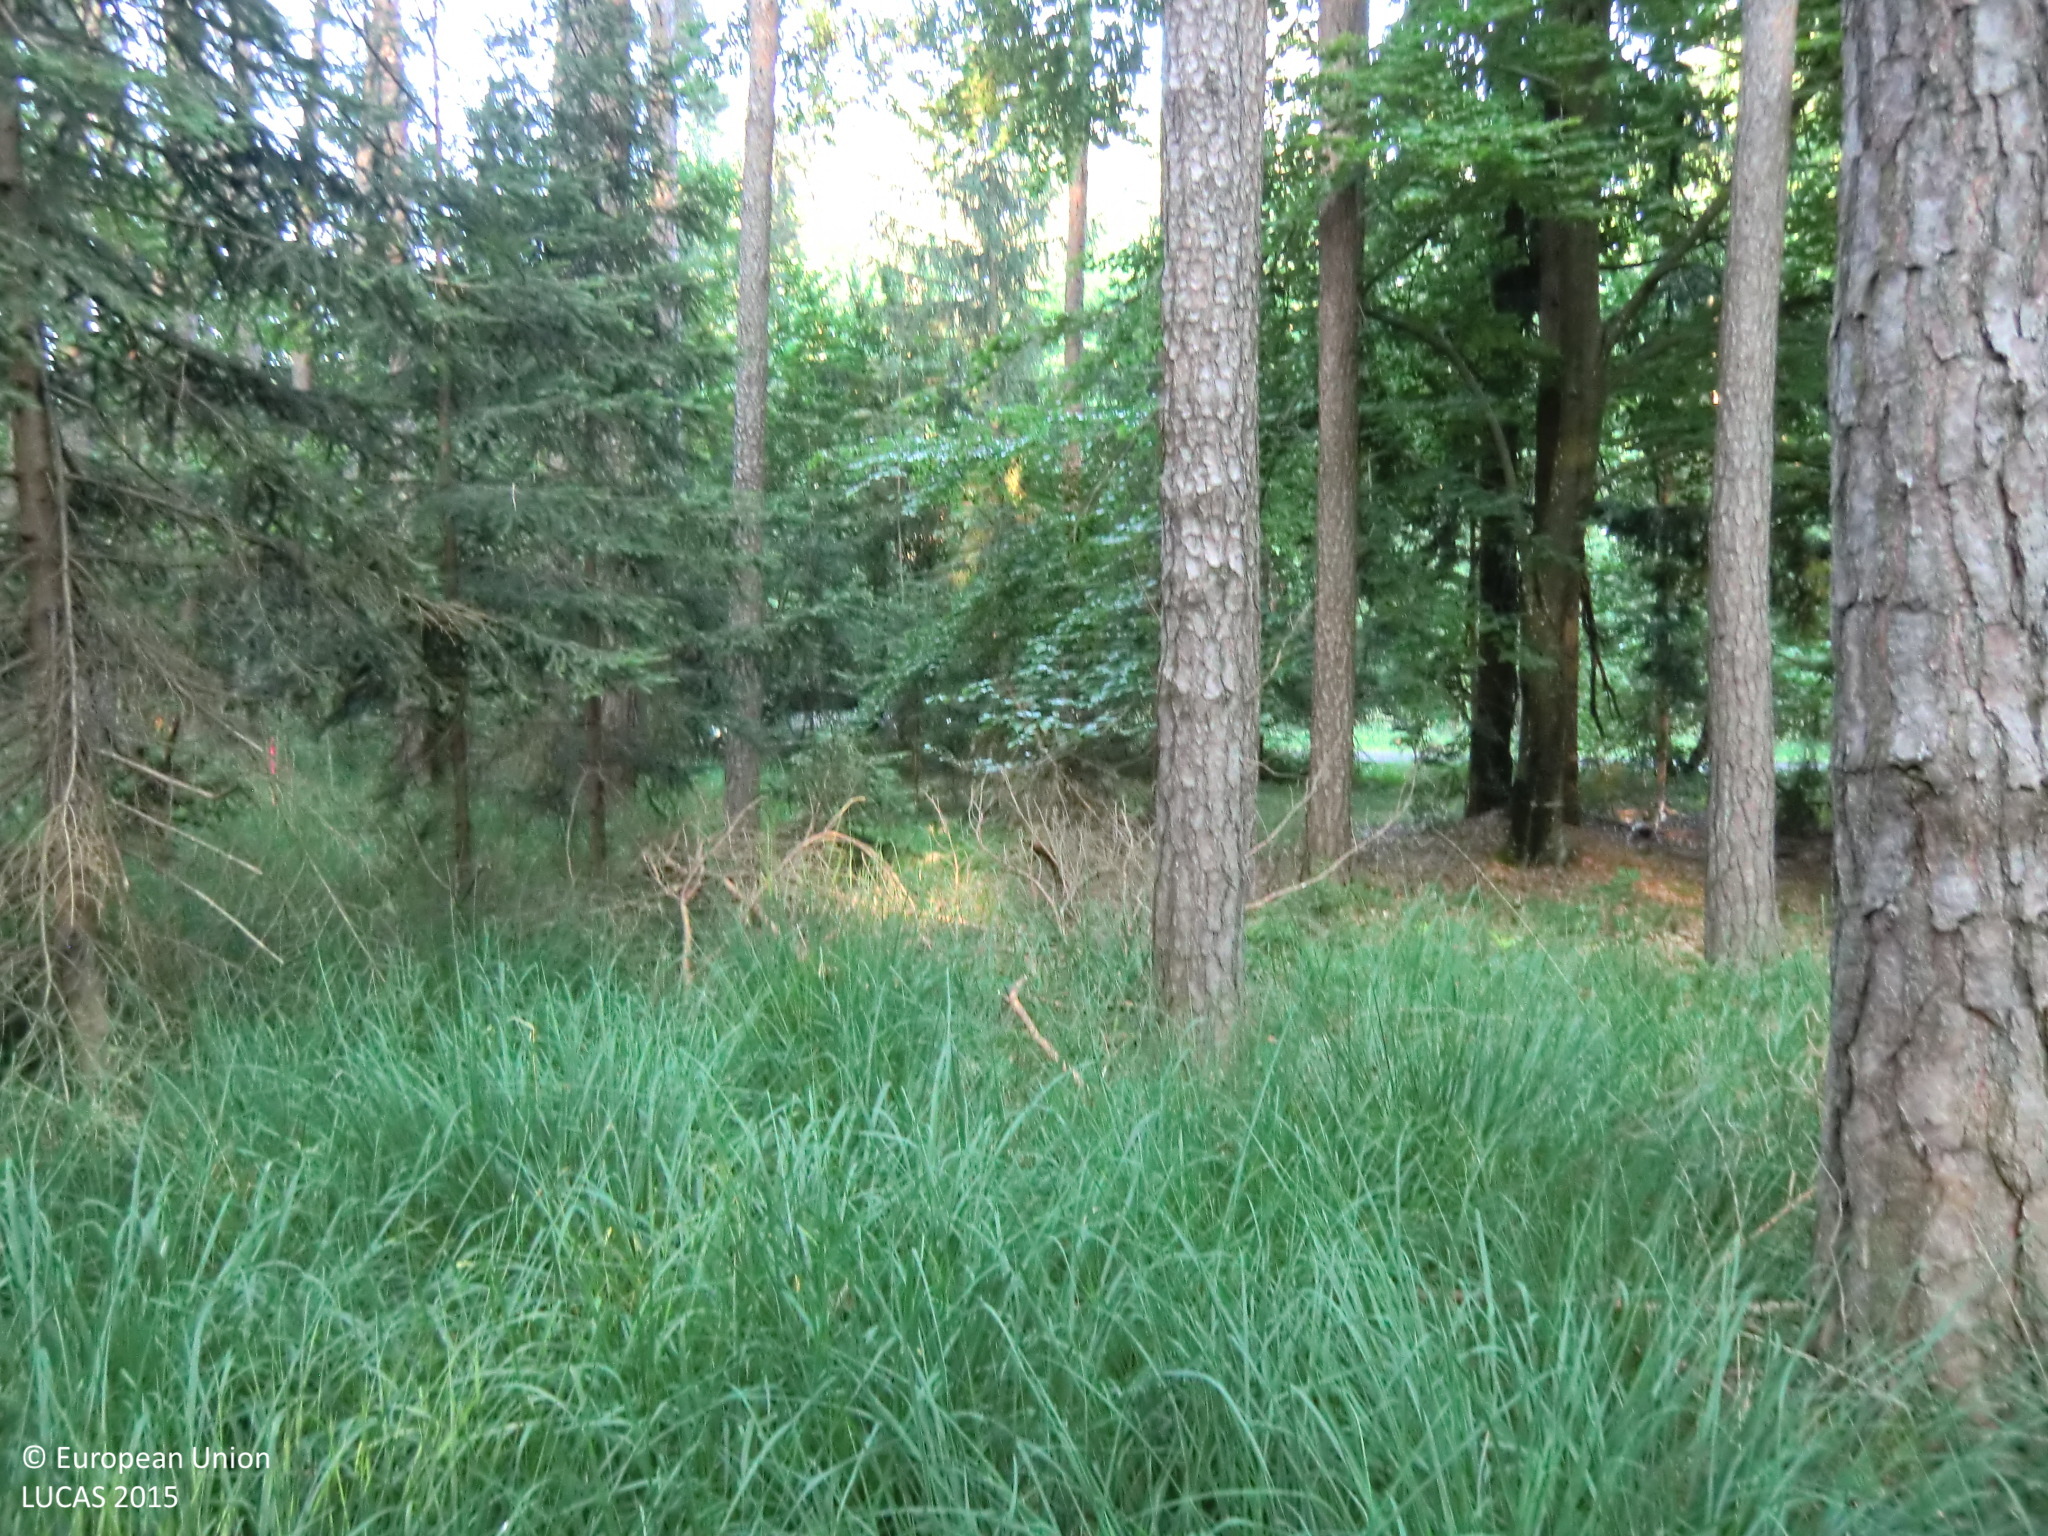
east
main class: Woodland
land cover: Pine dominated coniferous woodland
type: hemiboreal forest and nemoral coniferous forest and mixed broadleaved-coniferous forest
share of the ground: > 75 %
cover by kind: coniferous forest trees 70 %, herbaceous plants 25 %, broadleaved forest trees 5 %
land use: Forestry
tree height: > 5 m
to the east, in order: Pine dominated coniferous woodland; Grass margins; Paved roads, cycling and walking lanes; Grass margins; Pine dominated coniferous woodland; Tracks; Pine dominated coniferous woodland
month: July
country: AT
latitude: 47.1605
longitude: 15.9502
